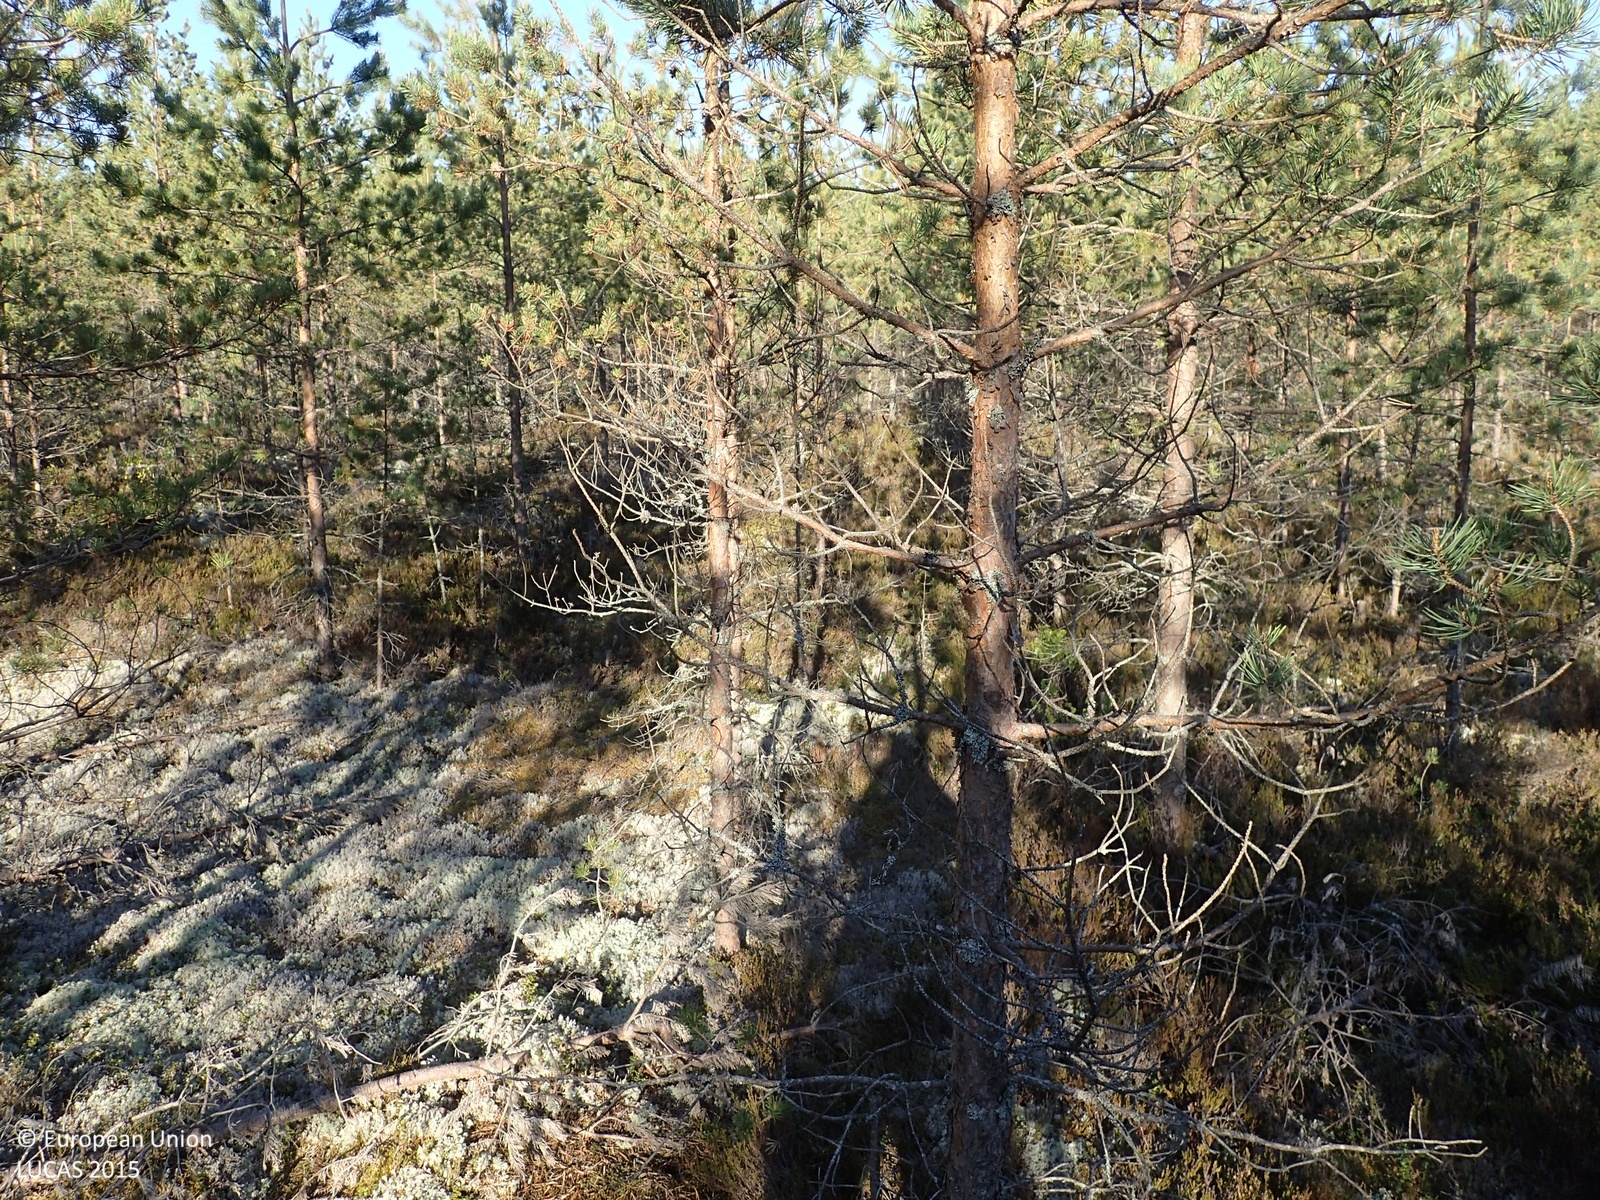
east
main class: Woodland
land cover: Pine dominated coniferous woodland
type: boreal forest
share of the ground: > 75 %
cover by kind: coniferous forest trees 75 %, shrubs 20 %, lichens and mosses 5 %
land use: Forestry
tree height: > 5 m
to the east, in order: Pine dominated coniferous woodland
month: June
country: FI
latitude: 62.3023
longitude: 21.9099
